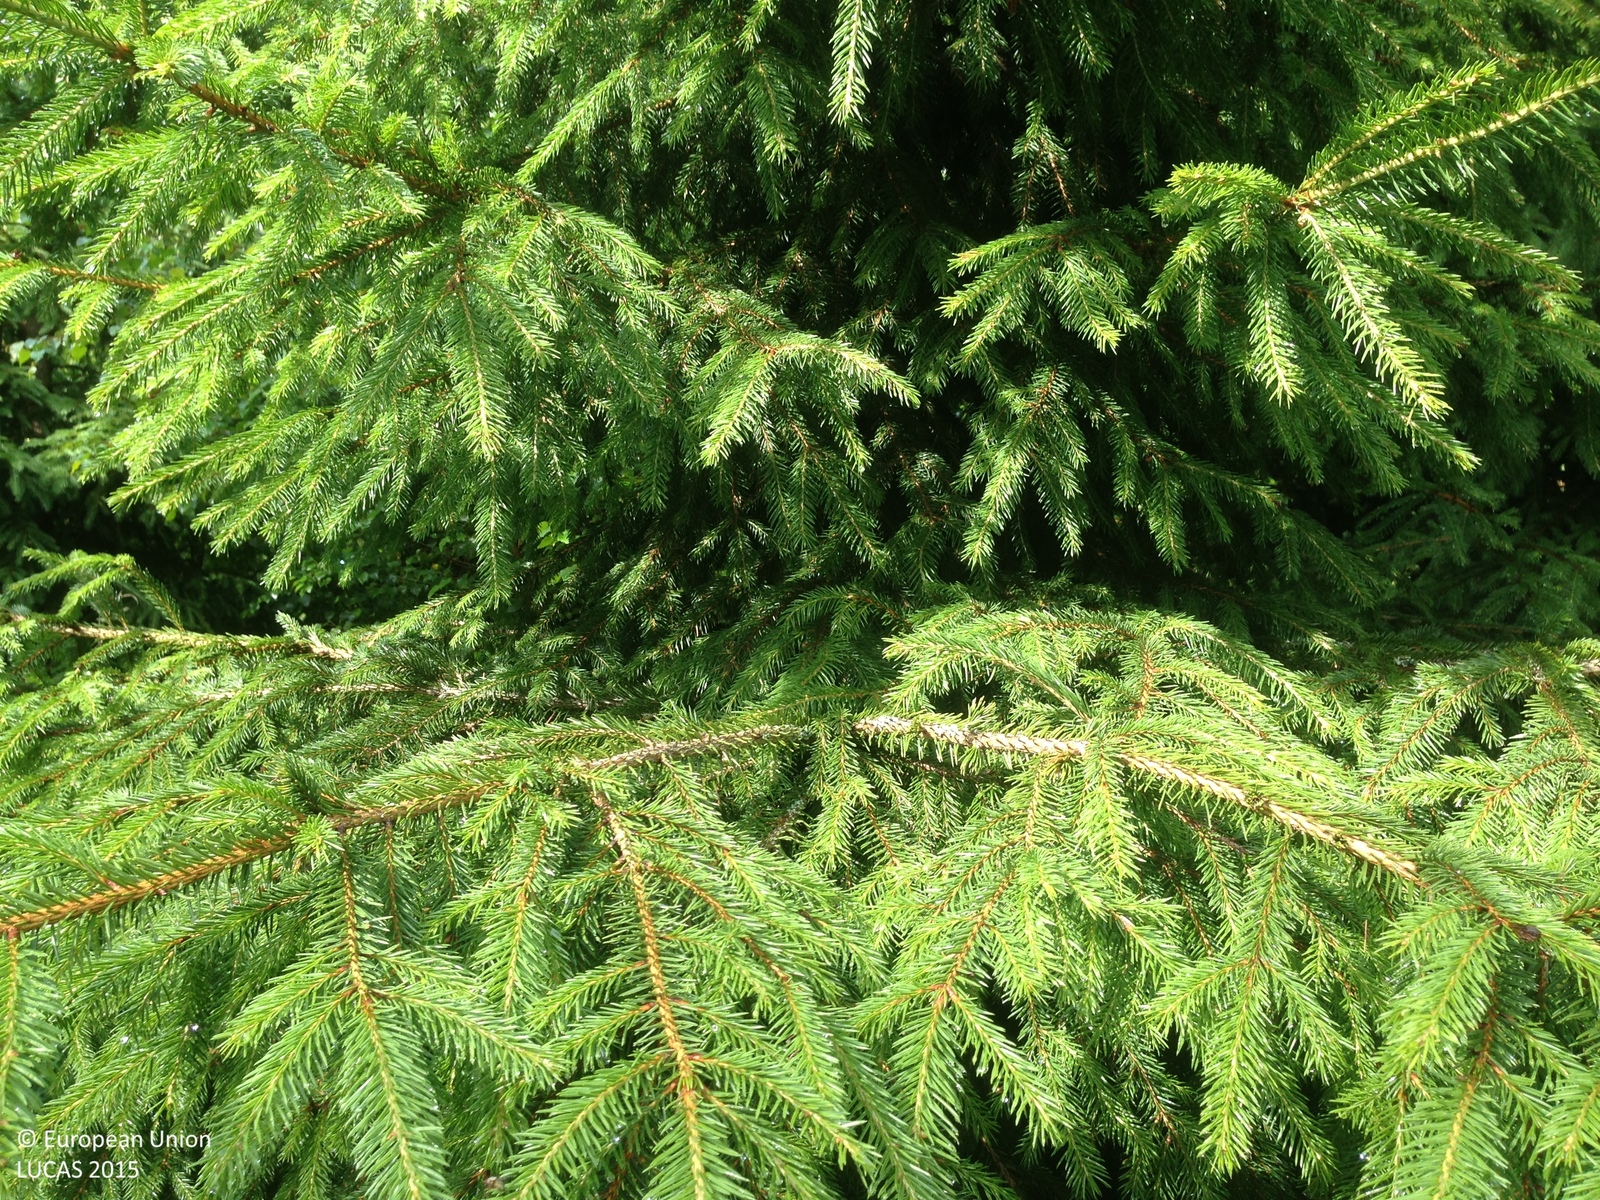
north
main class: Woodland
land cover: Spruce dominated mixed woodland
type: boreal forest
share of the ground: 25 - 50 %
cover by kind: herbaceous plants 60 %, coniferous forest trees 30 %, broadleaved forest trees 10 %
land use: Forestry
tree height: > 5 m
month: July
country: SE
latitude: 59.9177
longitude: 18.6017
